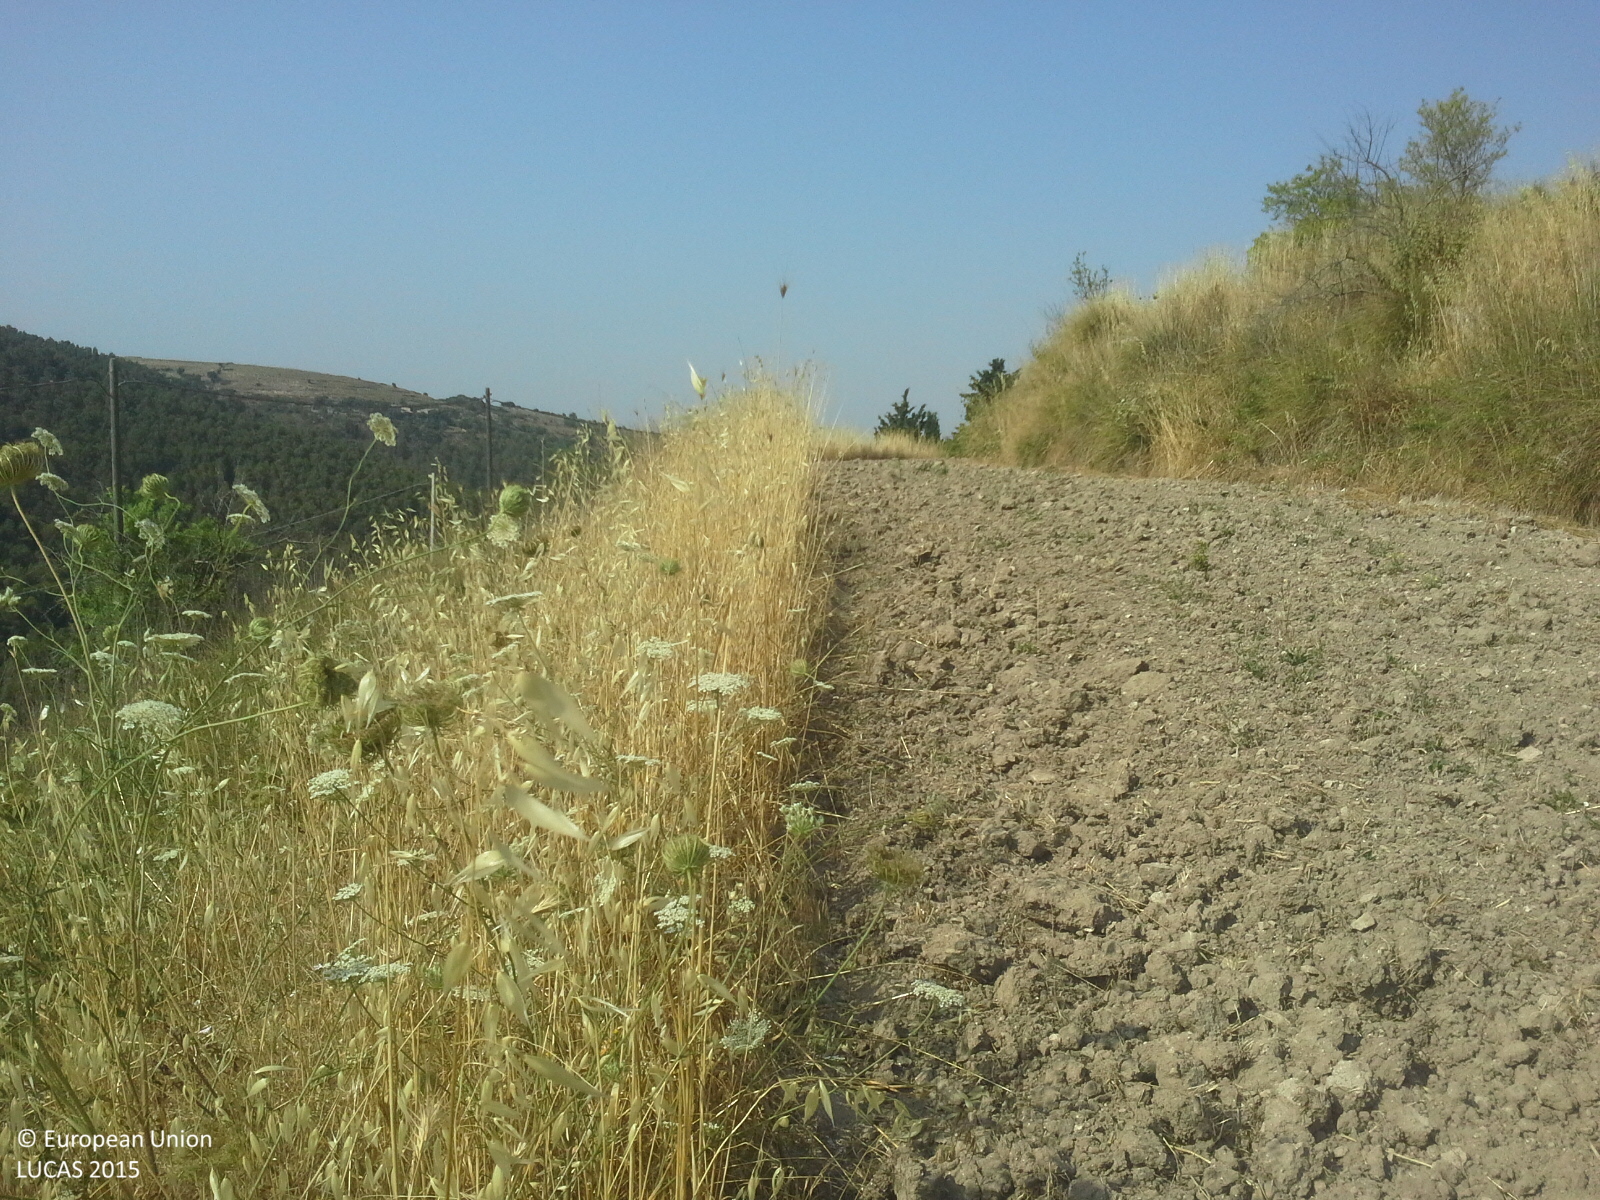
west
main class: Grassland
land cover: Grassland without tree/shrub cover
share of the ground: > 75 %
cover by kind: herbaceous plants 100 %
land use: Semi-natural and natural areas not in use
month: July
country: IT
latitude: 36.9543
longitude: 14.7801
